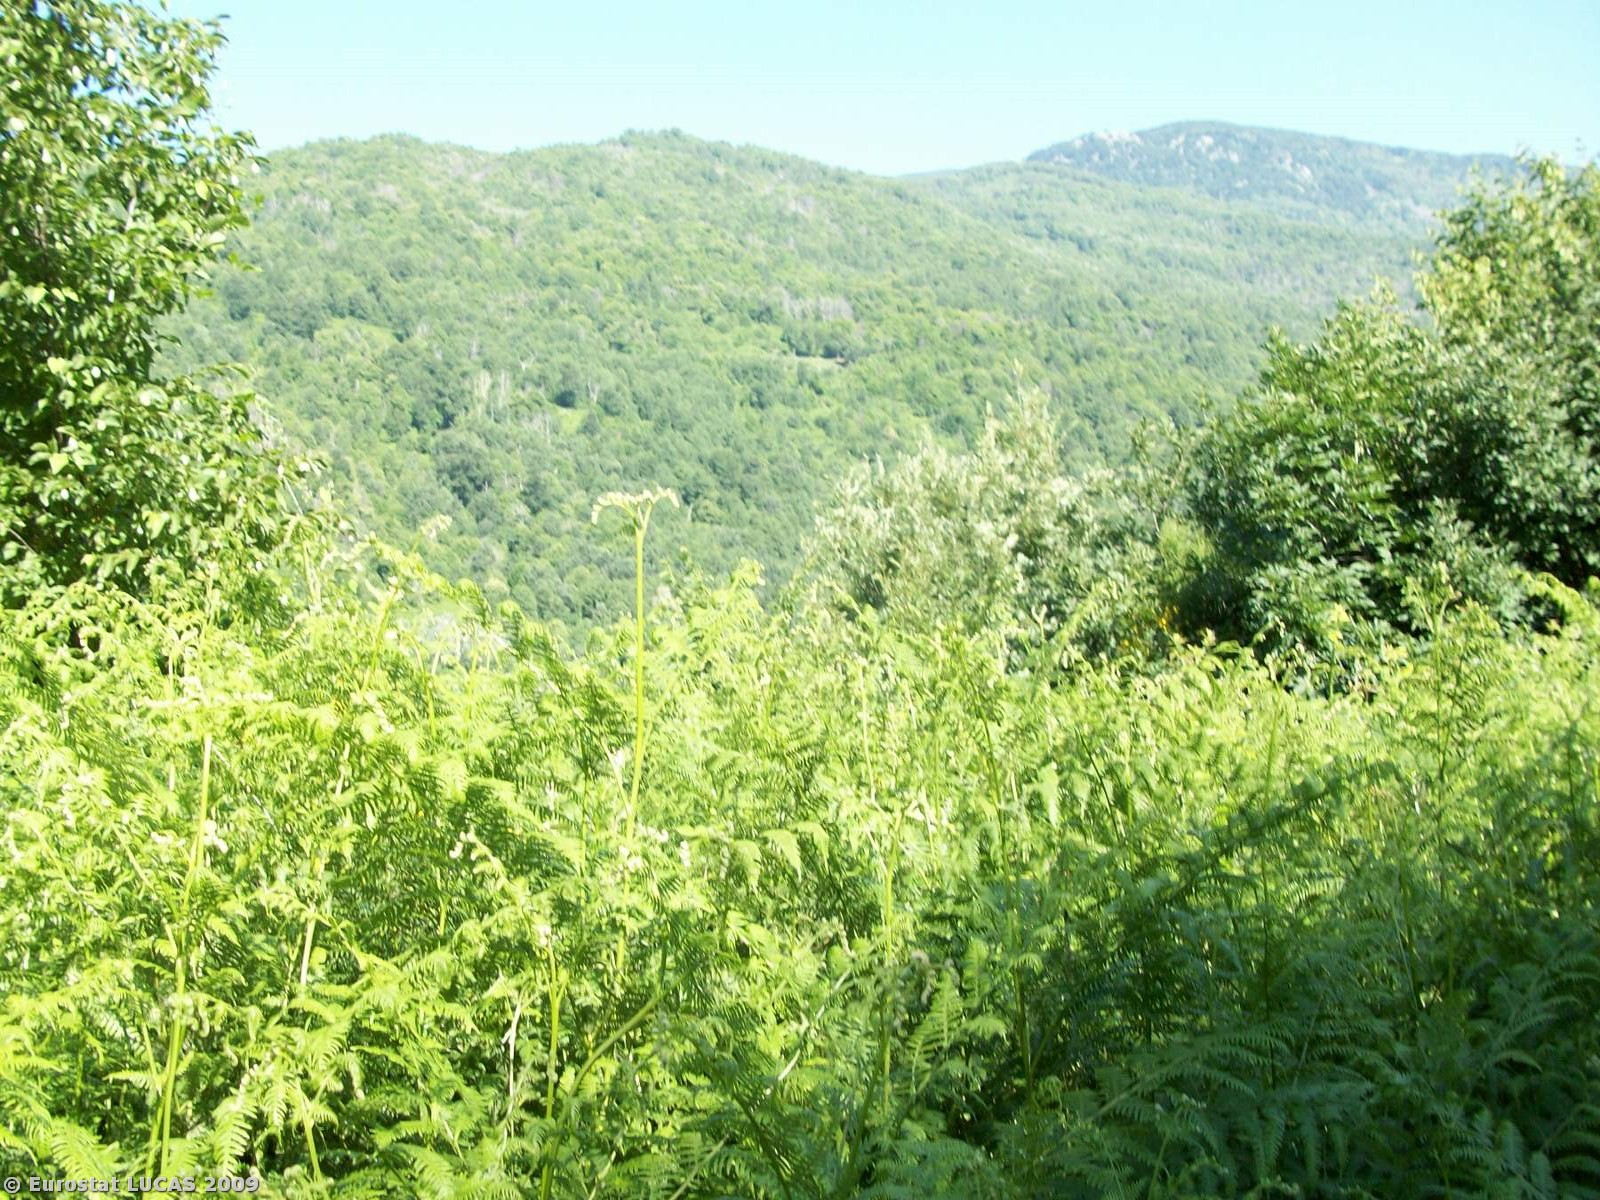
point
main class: Woodland
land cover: Mixed woodland
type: mesophytic deciduous forest
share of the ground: > 75 %
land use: Forestry
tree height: > 5 m
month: June
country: IT
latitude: 39.7161
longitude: 16.0731
